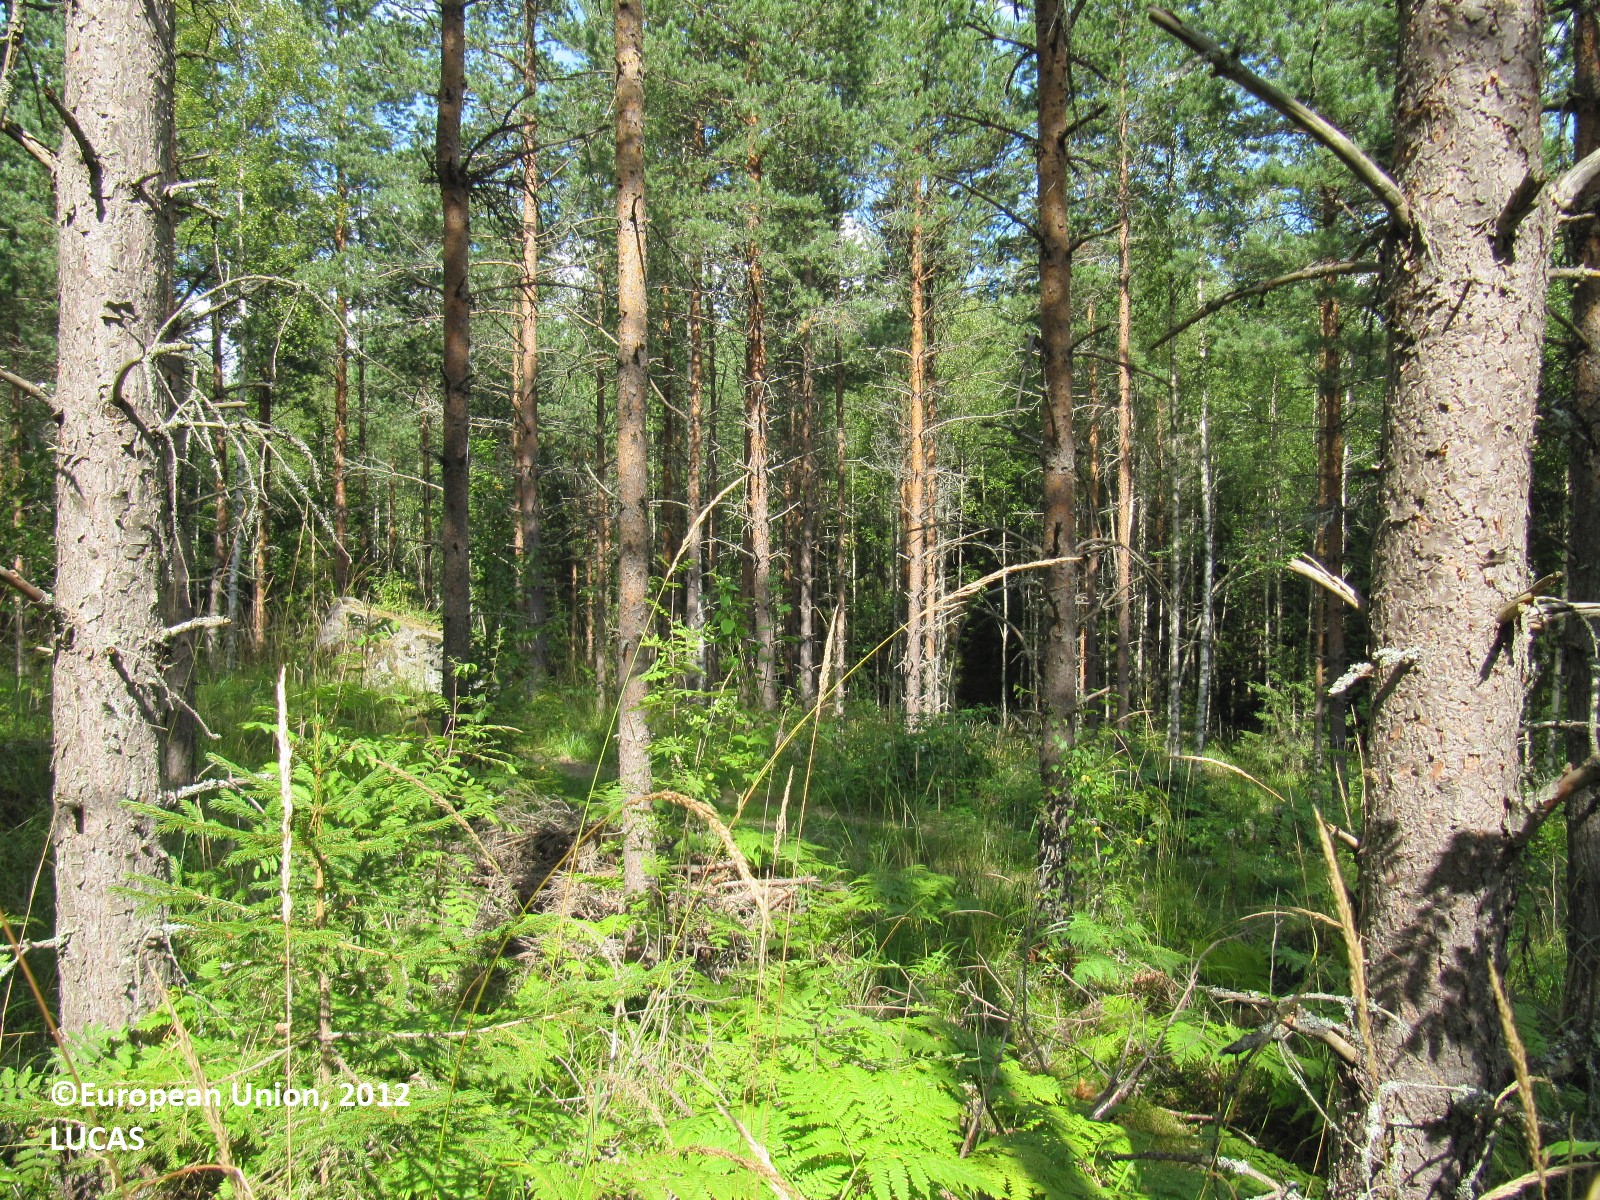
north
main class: Woodland
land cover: Pine dominated mixed woodland
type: boreal forest
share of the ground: 50 - 75 %
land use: Forestry
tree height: > 5 m
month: August
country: FI
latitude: 60.6911
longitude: 24.3309
